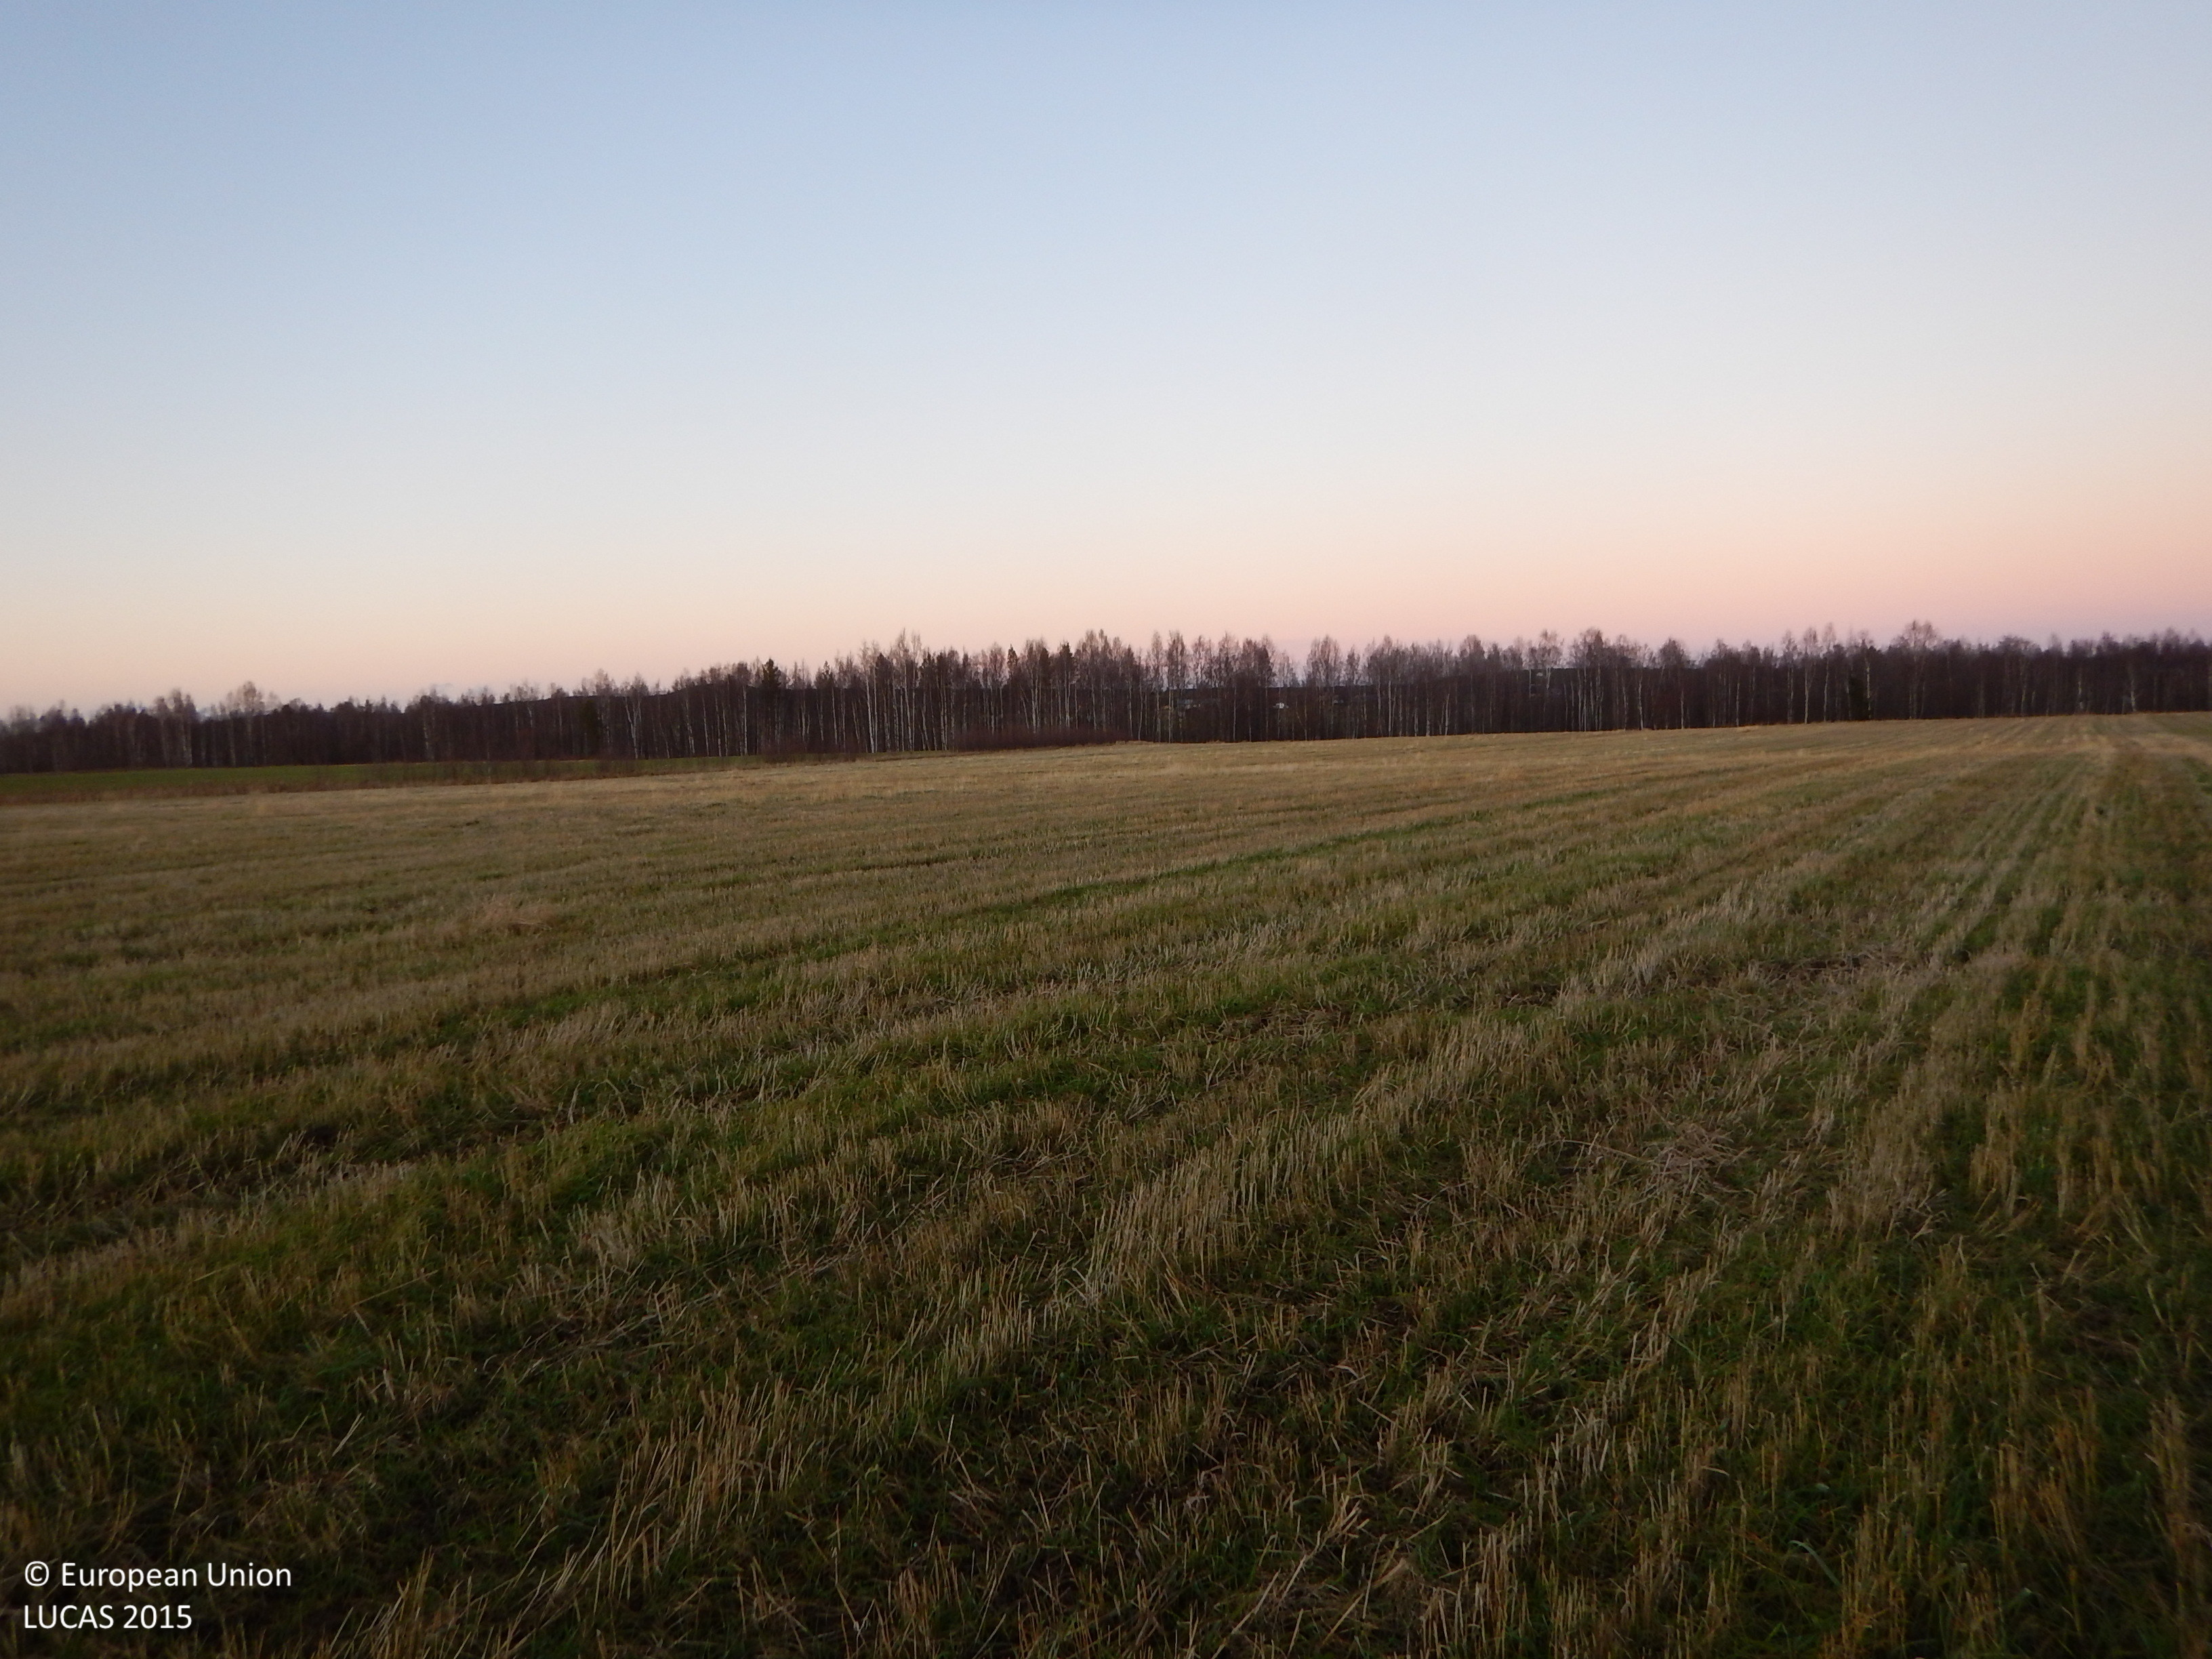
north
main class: Cropland
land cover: Temporary grasslands
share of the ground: > 75 %
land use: Agriculture (excluding fallow land and kitchen gardens)
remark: Harvested field
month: November
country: SE
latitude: 65.3351
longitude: 21.2057
